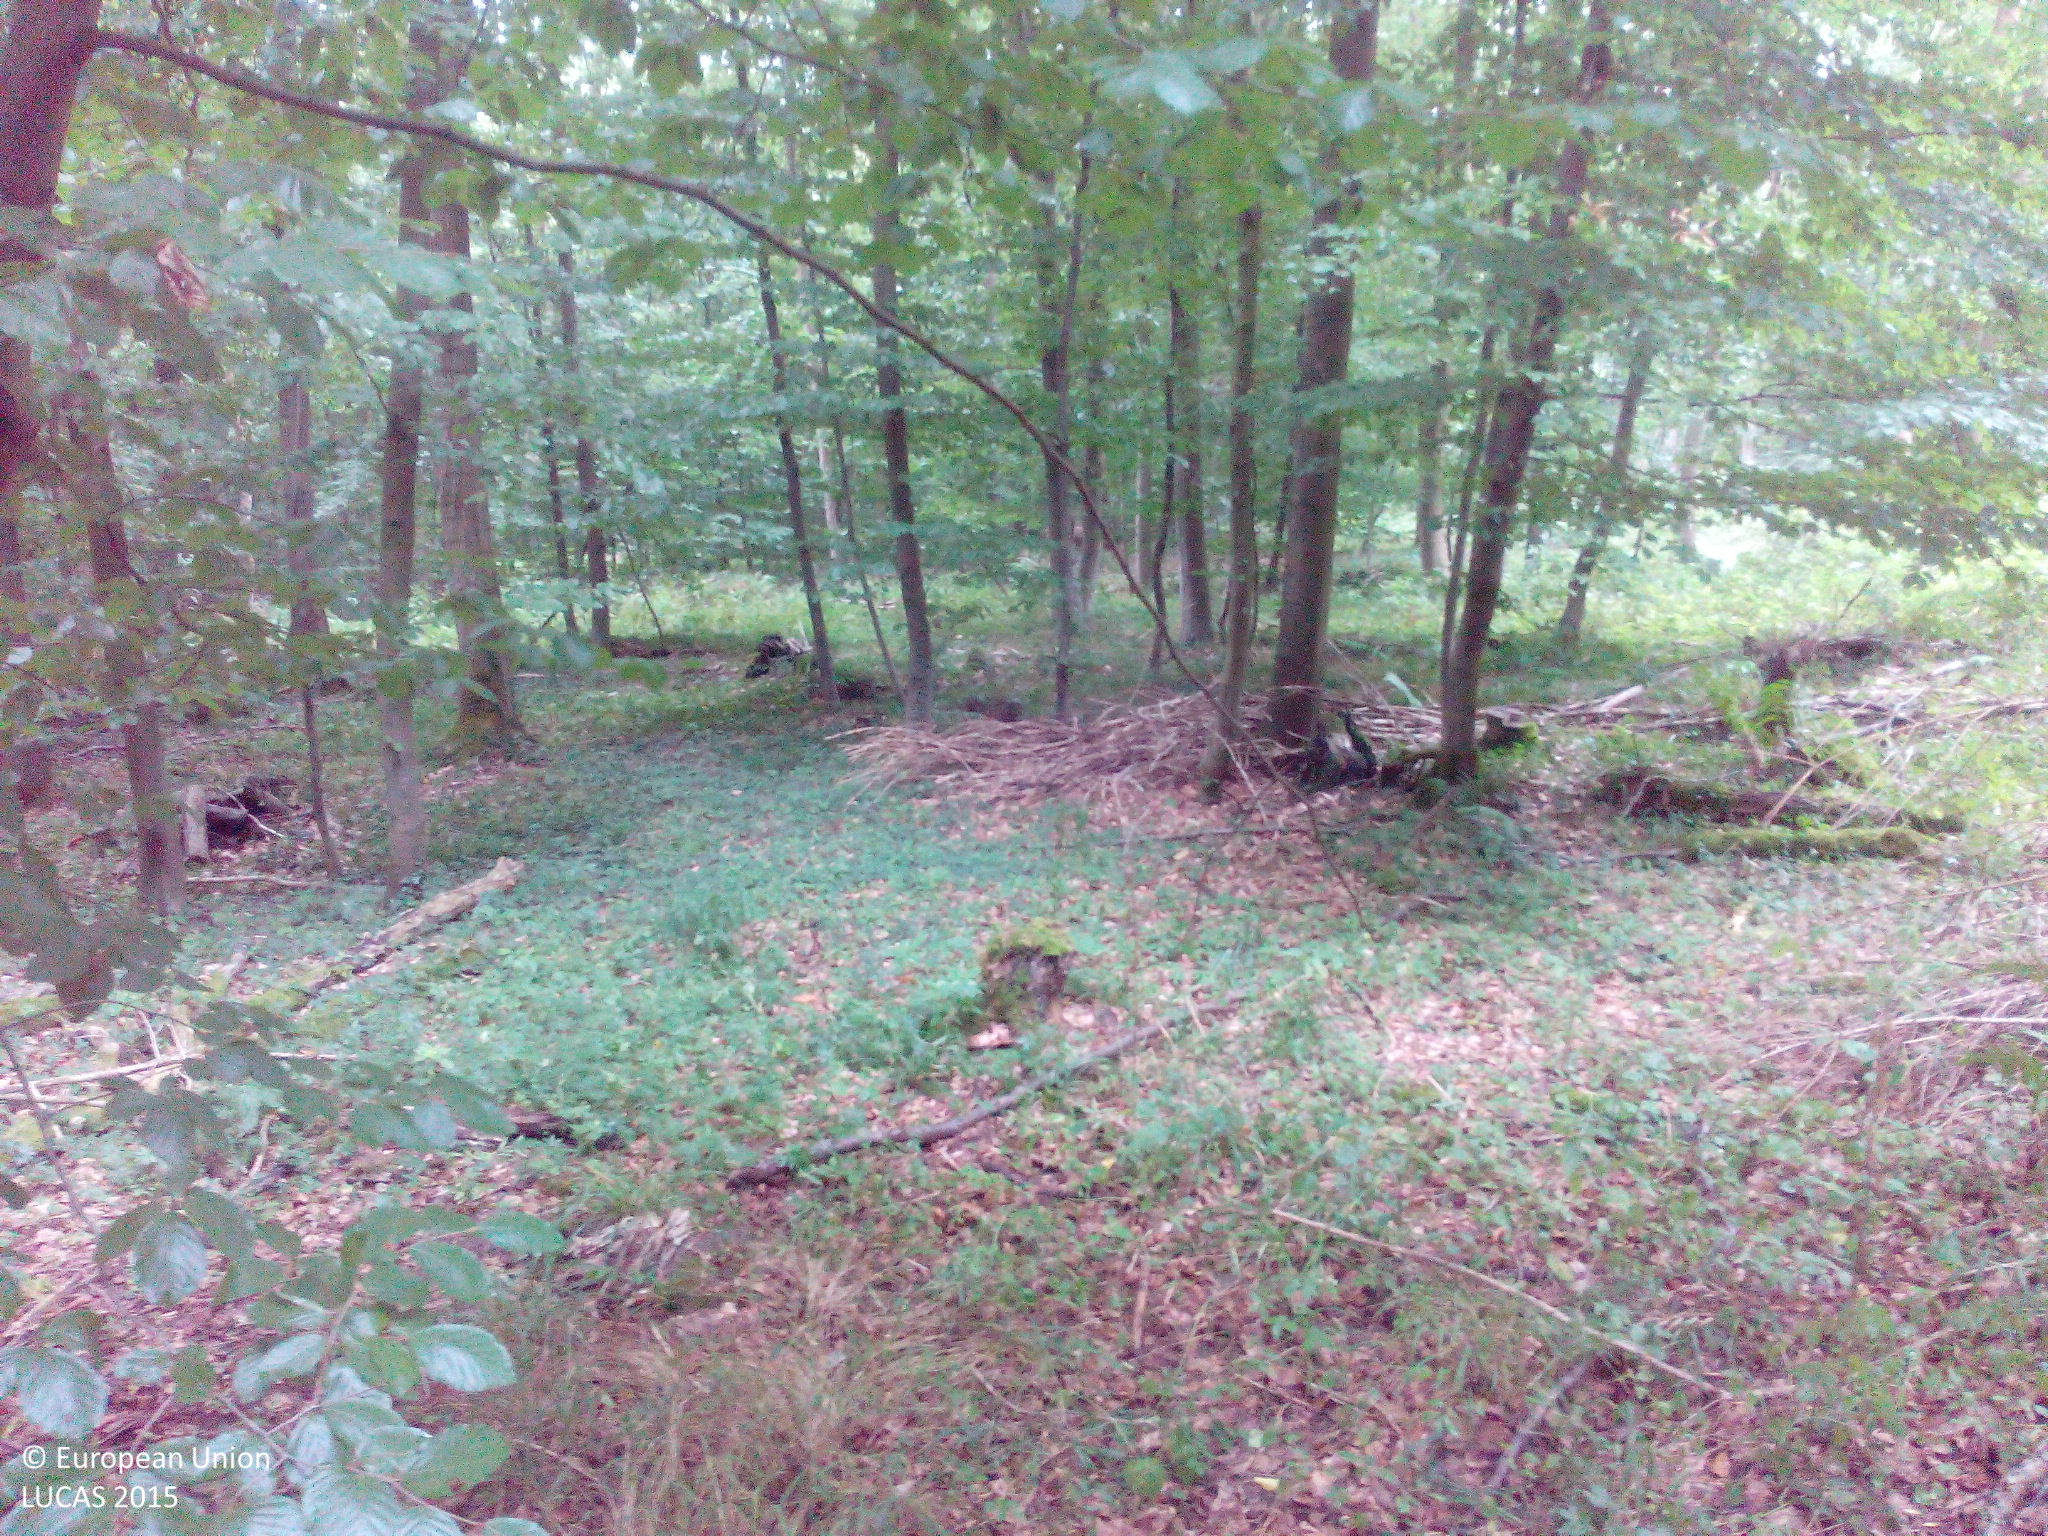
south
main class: Woodland
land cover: Broadleaved woodland
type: beech forest
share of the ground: > 75 %
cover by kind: broadleaved forest trees 85 %, unconsolidated bare surface 10 %, herbaceous plants 5 %
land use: Forestry
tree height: > 5 m
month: August
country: DE
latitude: 50.3469
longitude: 8.0189
